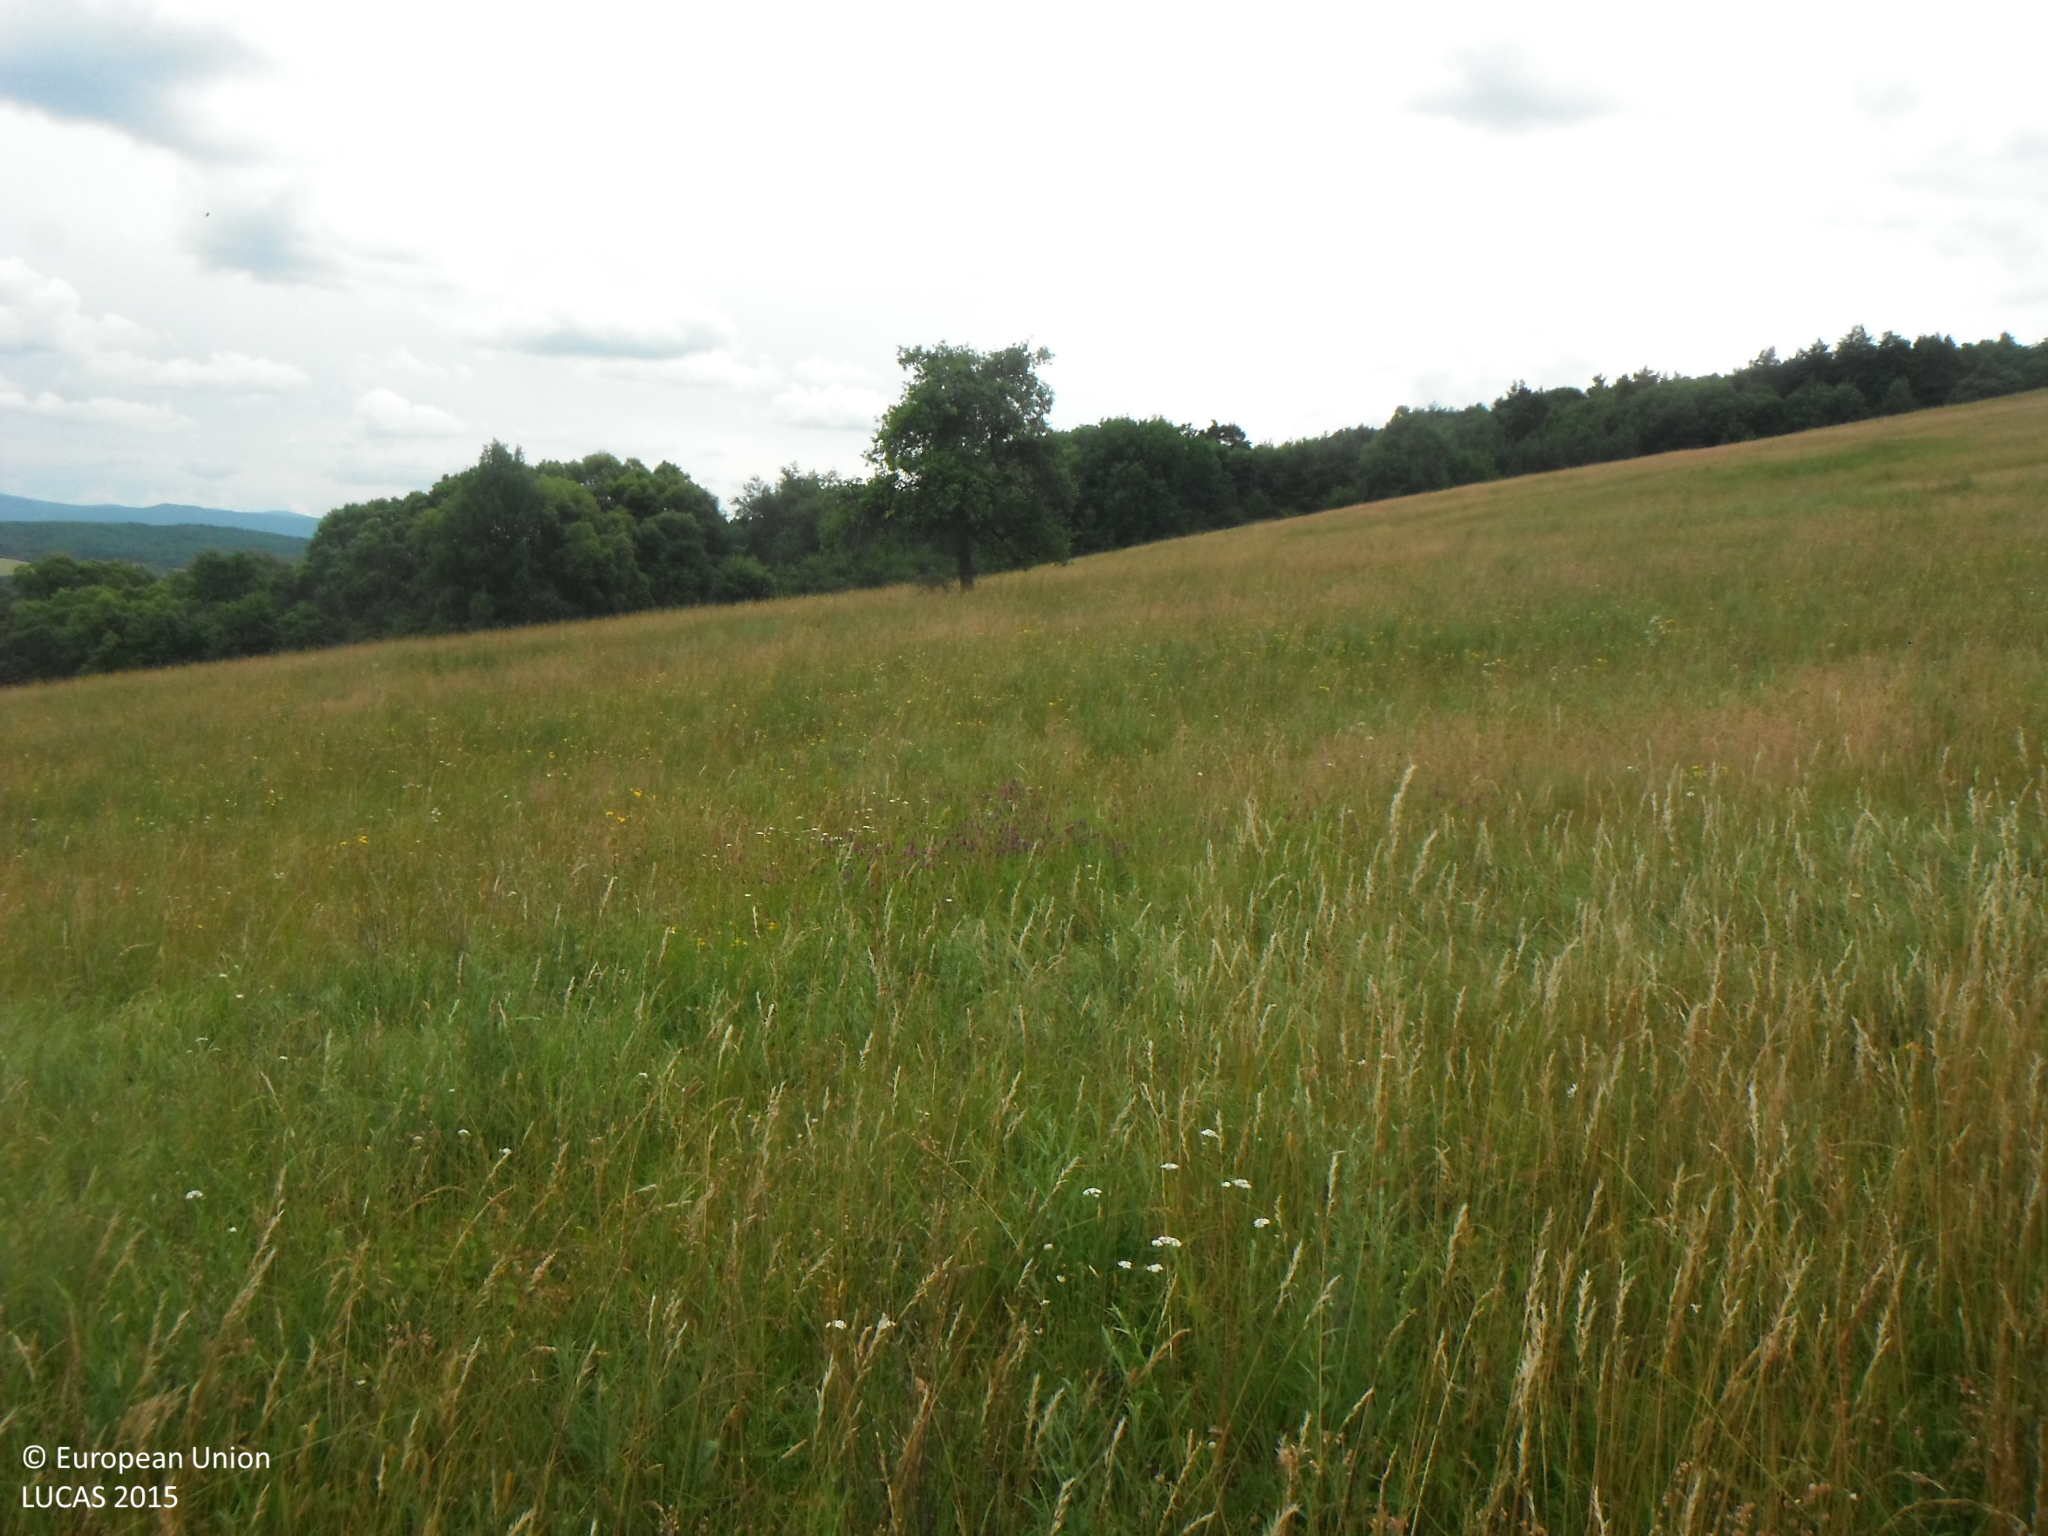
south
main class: Grassland
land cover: Grassland without tree/shrub cover
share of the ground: > 75 %
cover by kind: herbaceous plants 100 %
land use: Agriculture (excluding fallow land and kitchen gardens)
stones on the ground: < 10 %
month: June
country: SK
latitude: 49.0269
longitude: 21.9393
